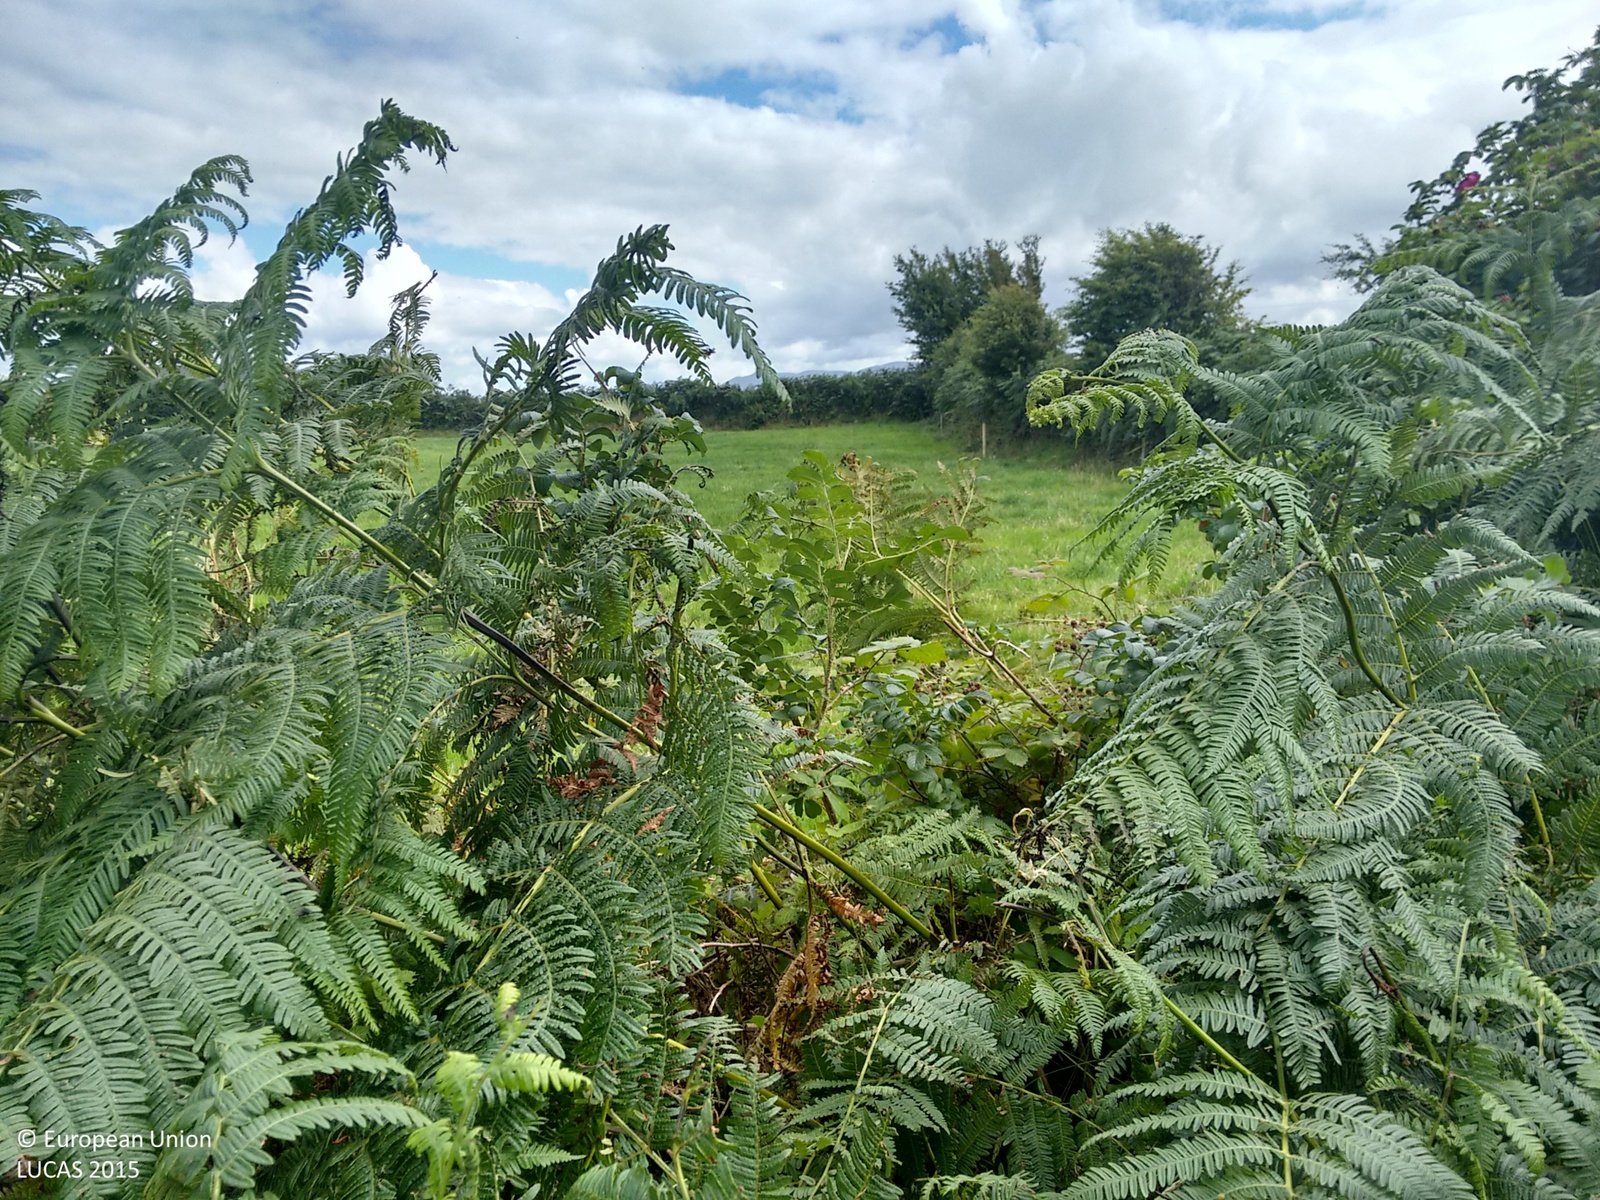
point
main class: Grassland
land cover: Grassland without tree/shrub cover
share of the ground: > 75 %
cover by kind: herbaceous plants 95 %, shrubs 5 %
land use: Agriculture (excluding fallow land and kitchen gardens)
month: August
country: IE
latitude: 52.1223
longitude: -9.7418
